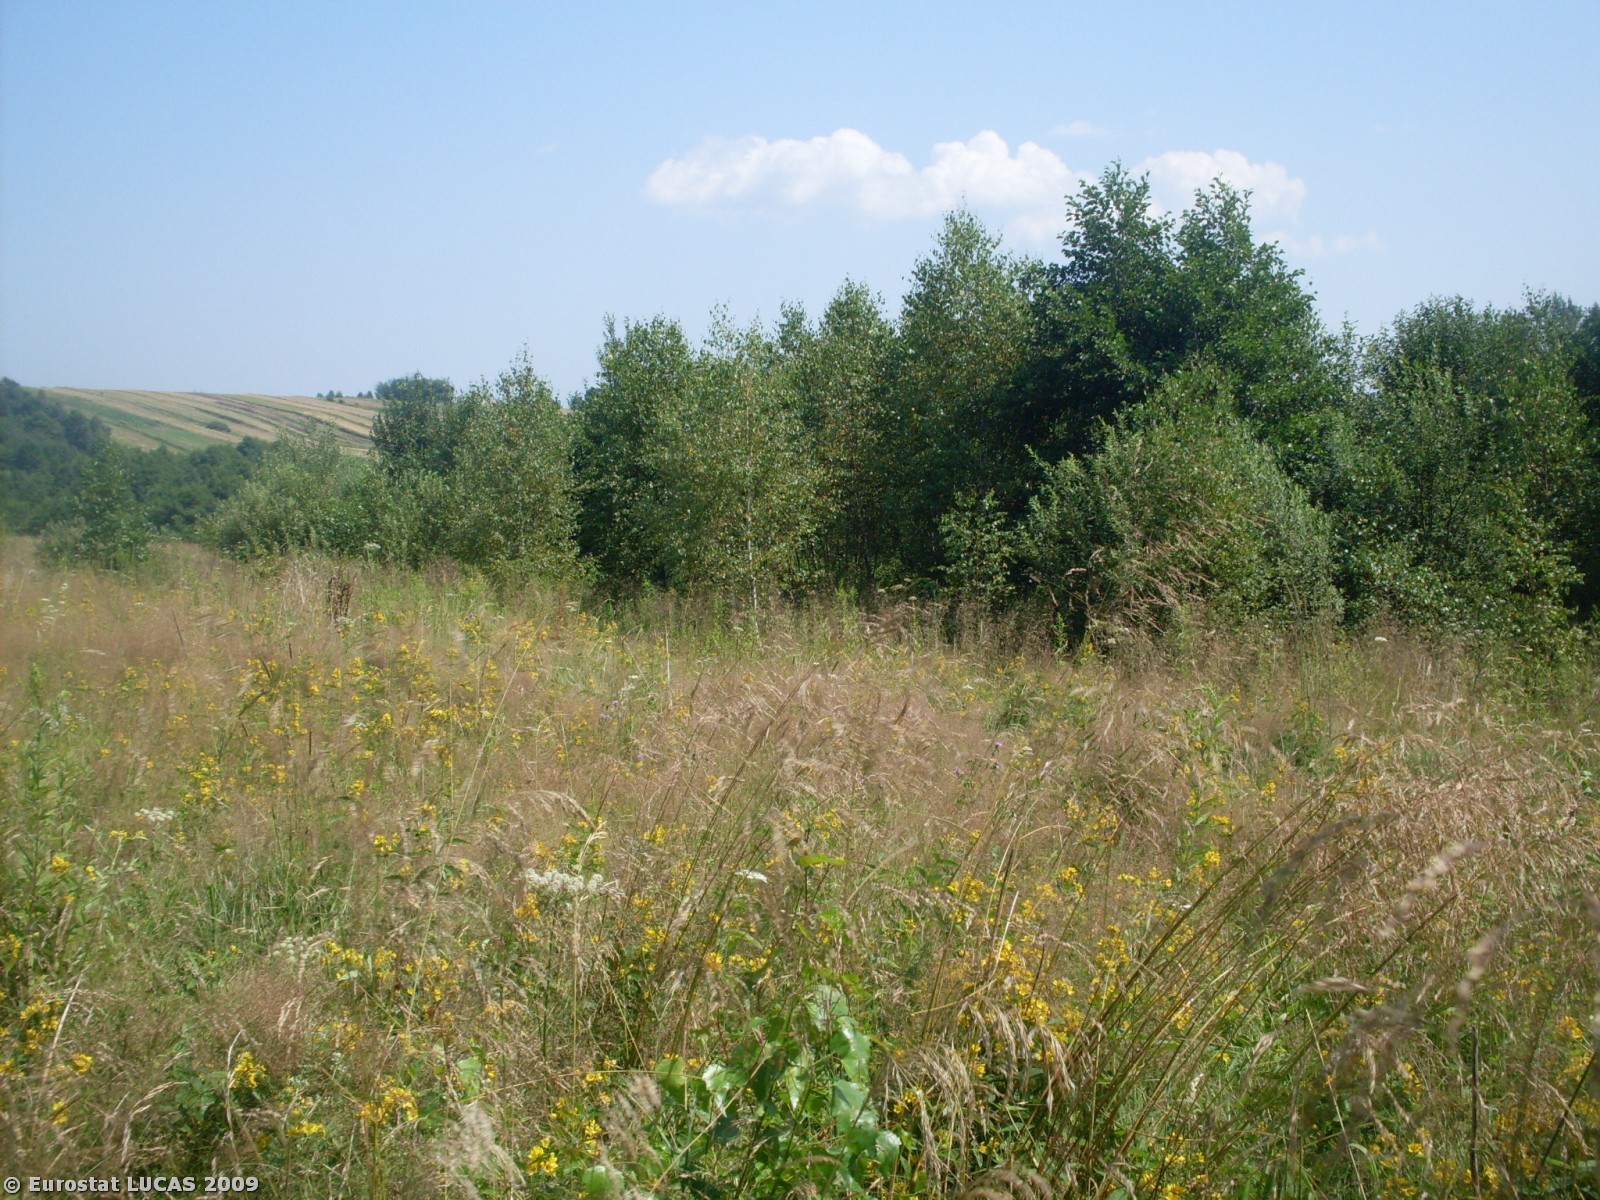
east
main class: Grassland
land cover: Grassland with sparse tree/shrub cover
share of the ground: > 75 %
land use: Unused
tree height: > 5 m
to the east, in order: Grassland with sparse tree/shrub cover; Broadleaved woodland; Grassland without tree/shrub cover; Rye; Grassland with sparse tree/shrub cover
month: August
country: PL
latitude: 49.9083
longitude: 20.5793
